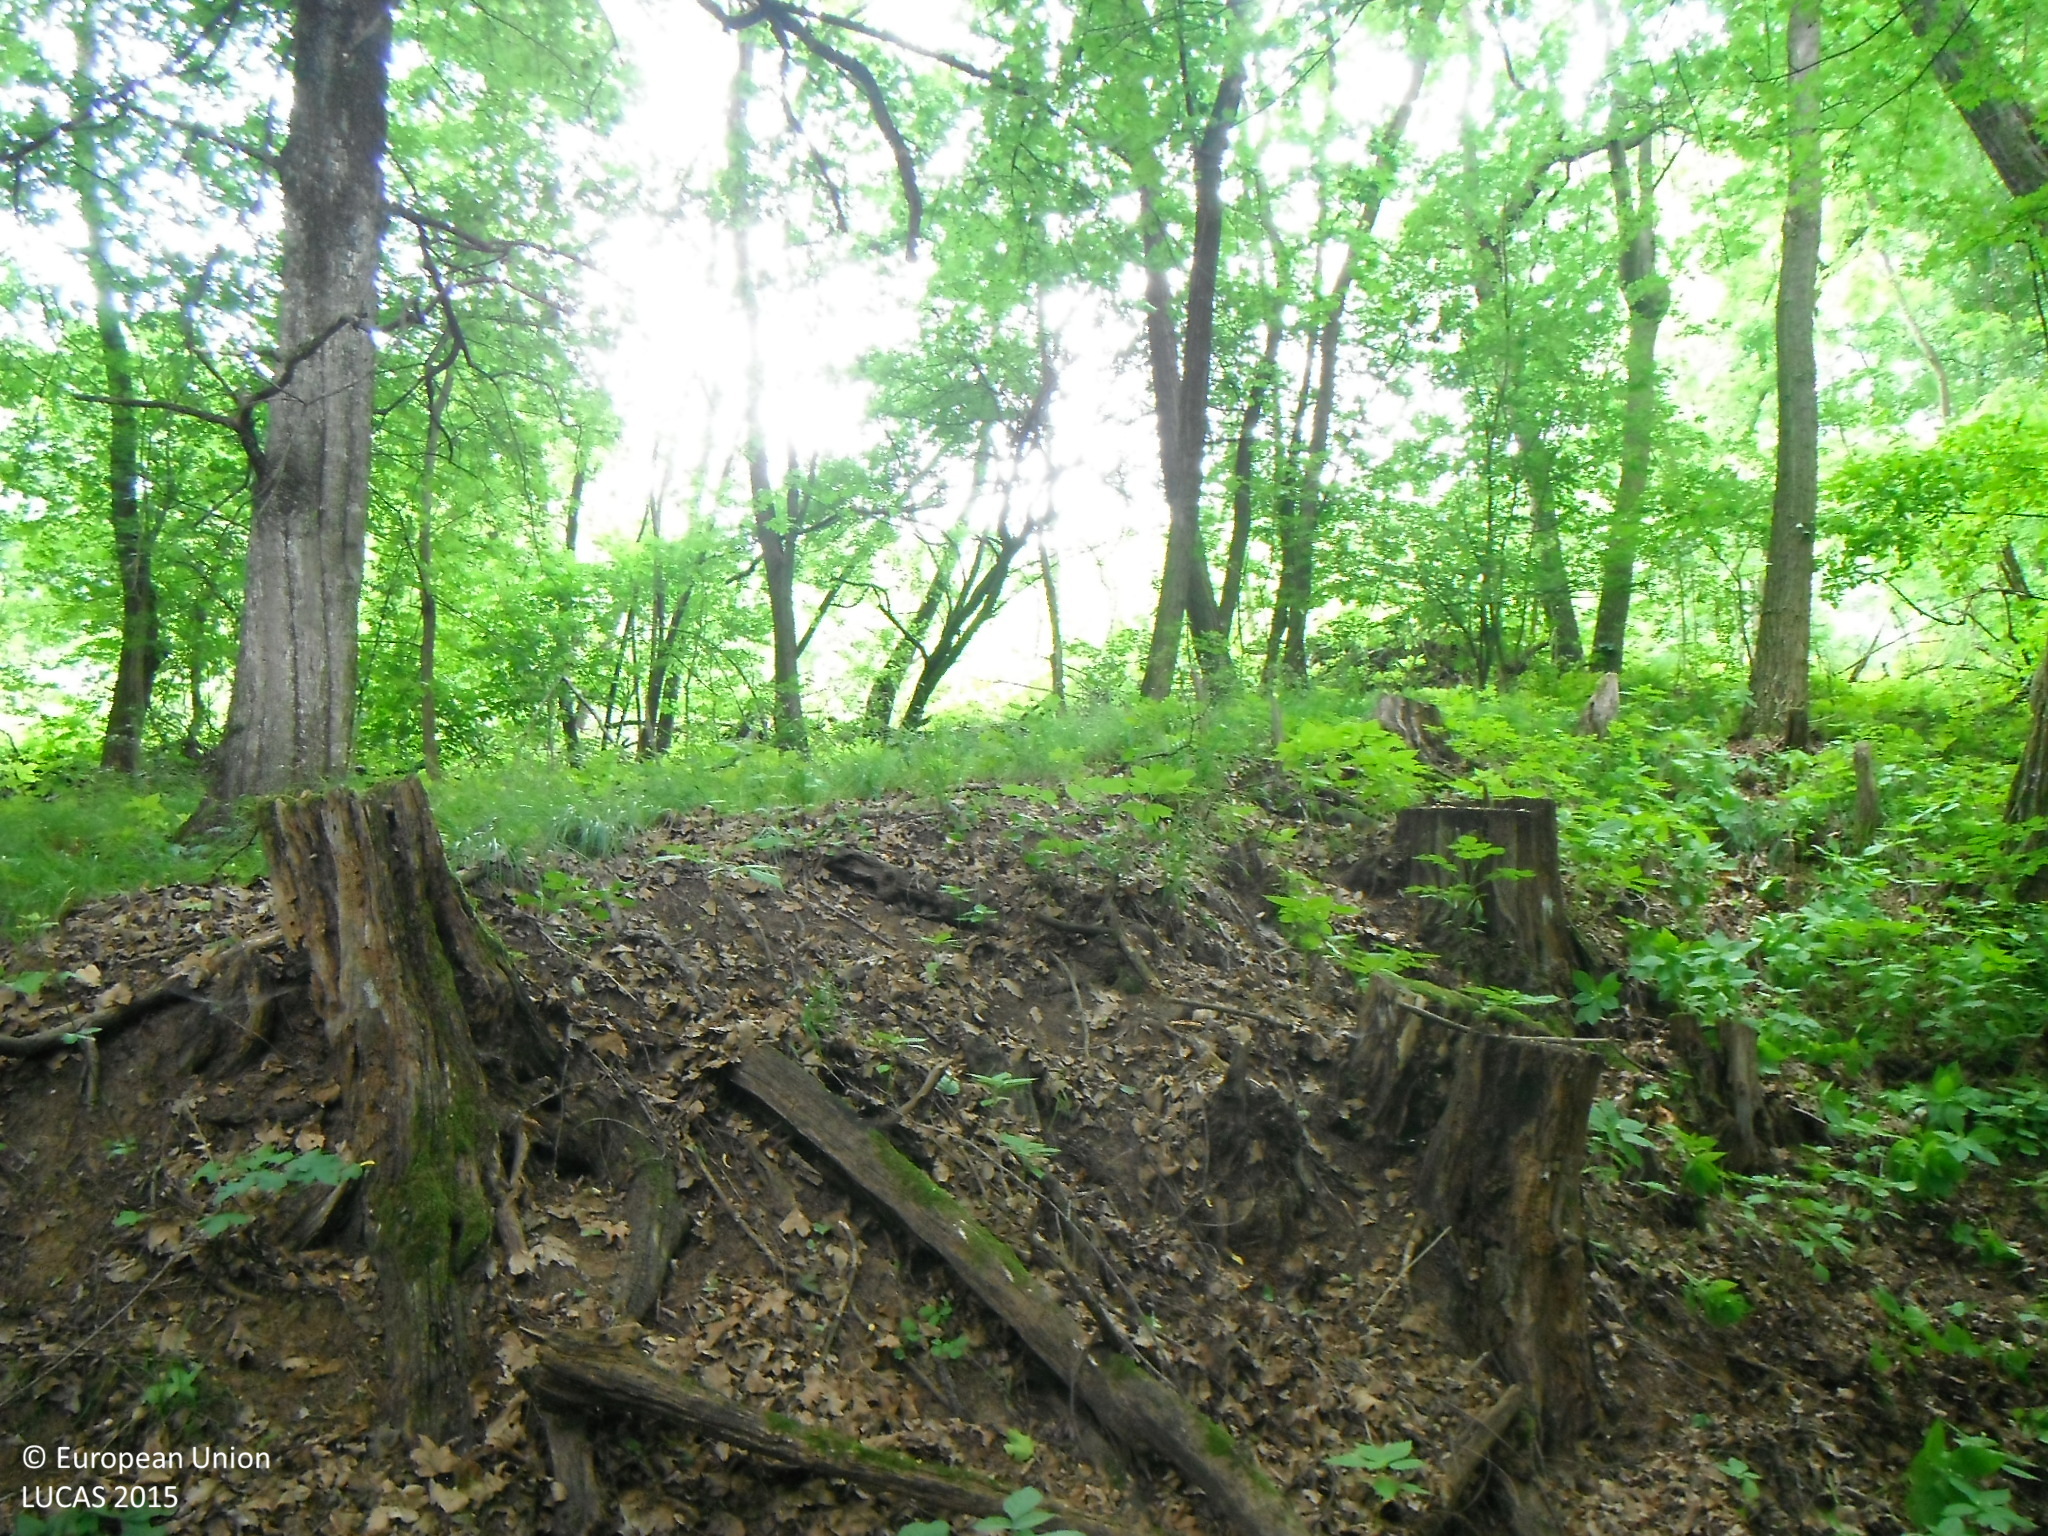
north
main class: Woodland
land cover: Broadleaved woodland
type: mesophytic deciduous forest
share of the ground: > 75 %
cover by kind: broadleaved forest trees 100 %
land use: Forestry
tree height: > 5 m
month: June
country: SK
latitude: 48.2773
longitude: 19.3610
